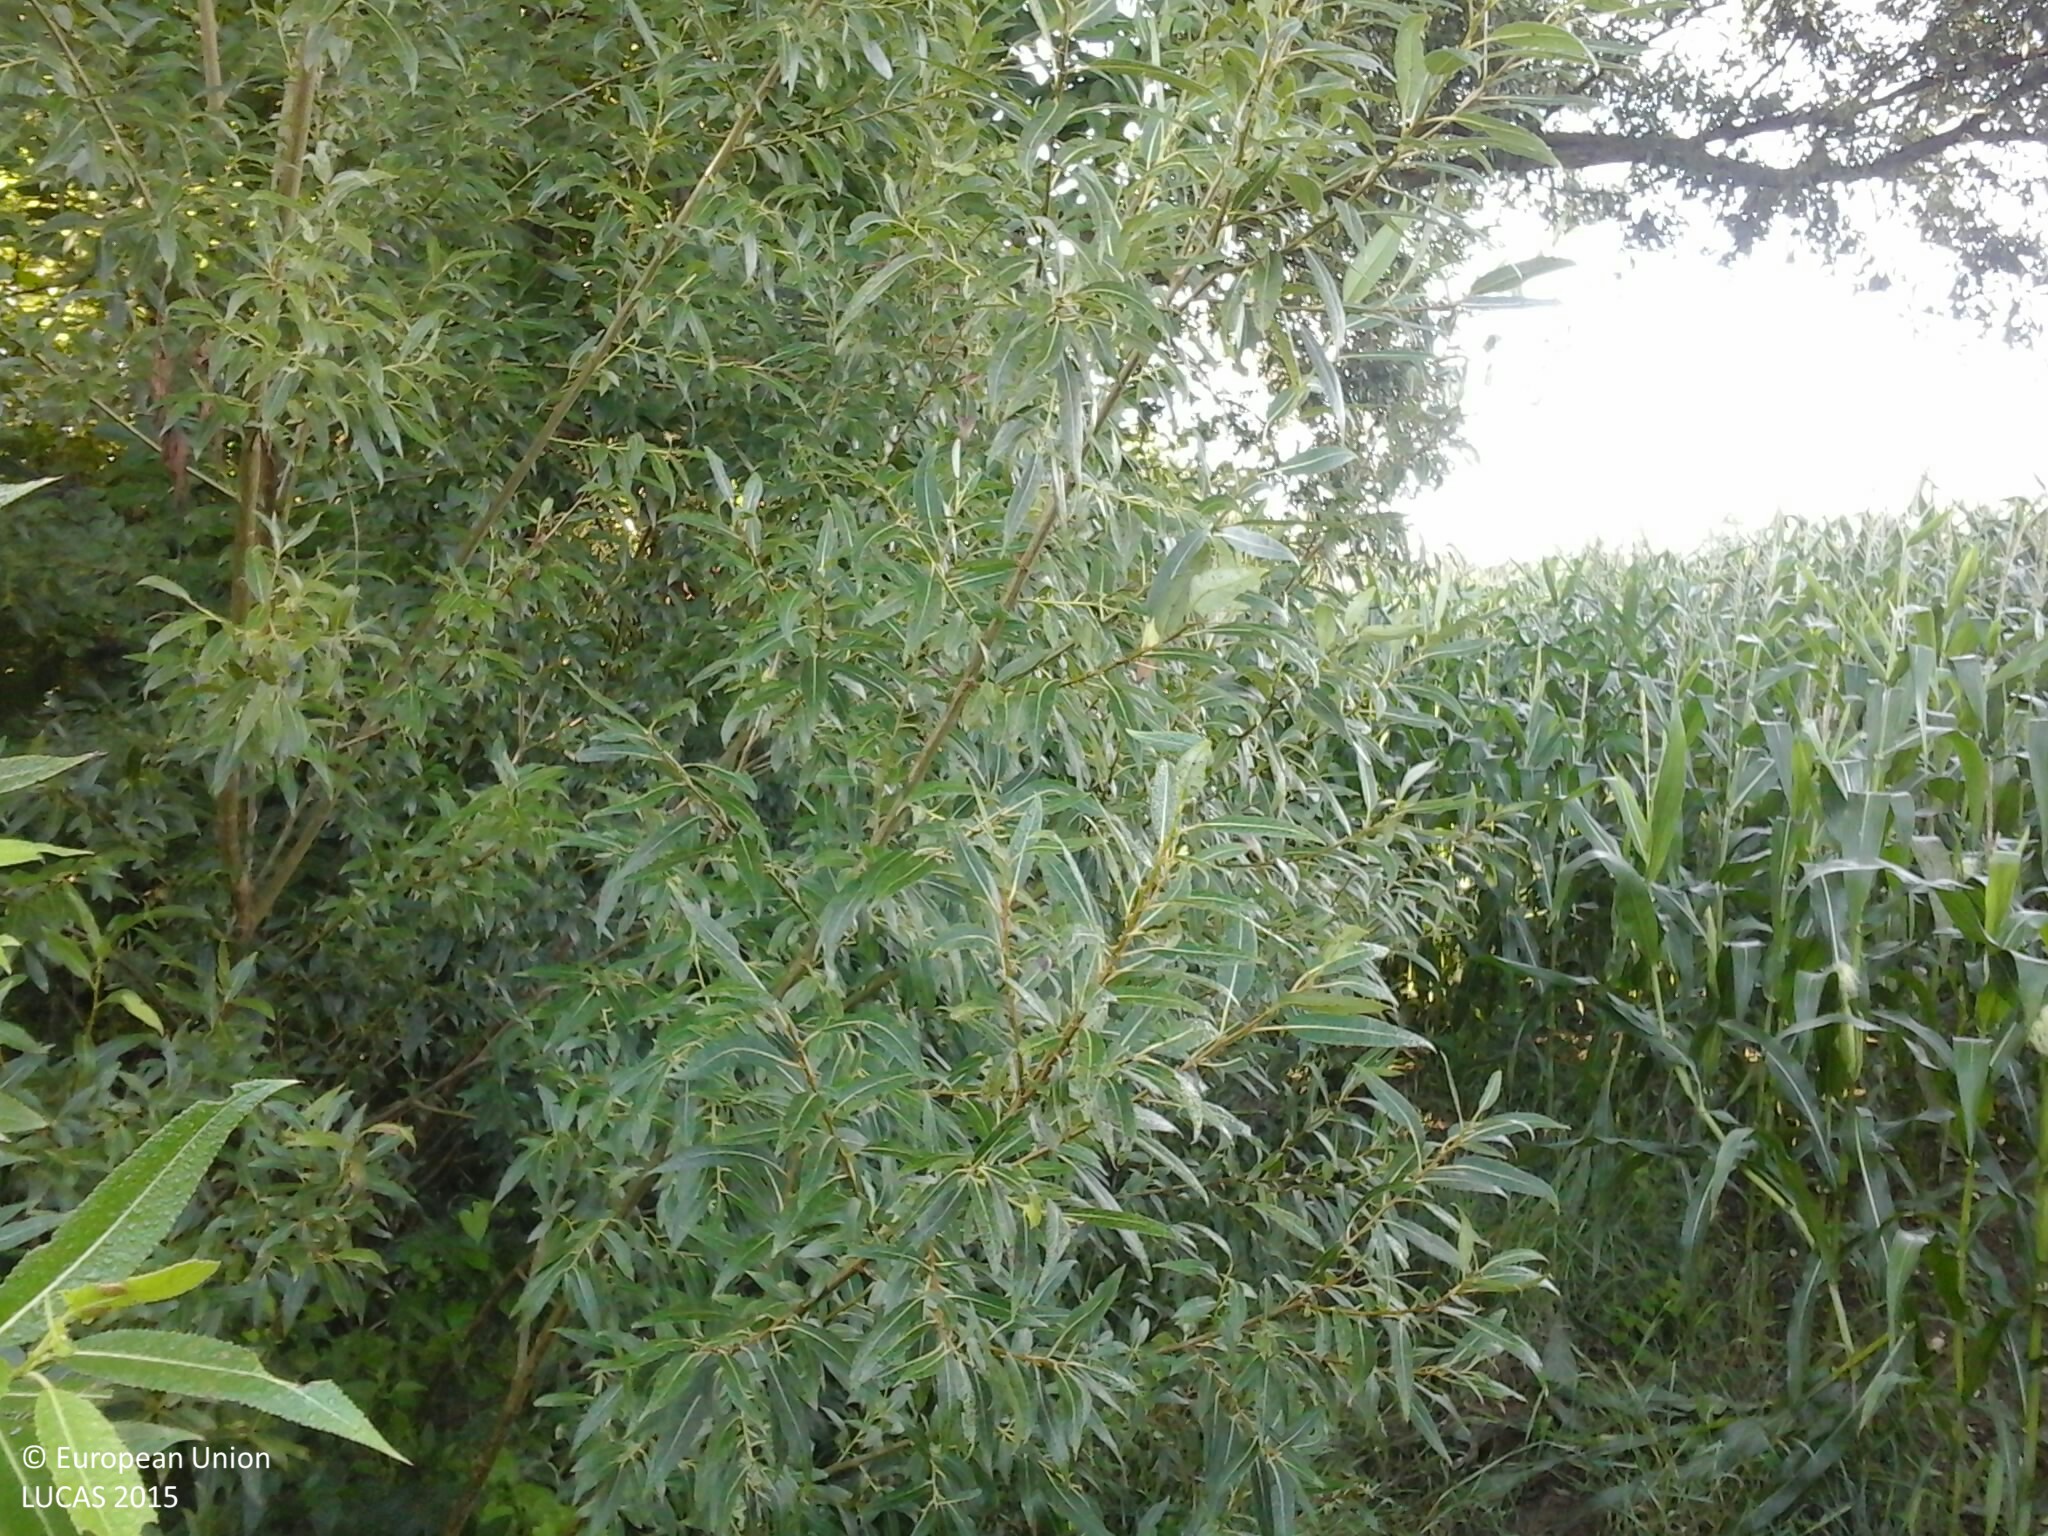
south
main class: Cropland
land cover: Maize
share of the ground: > 75 %
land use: Agriculture (excluding fallow land and kitchen gardens)
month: August
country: HU
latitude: 46.9579
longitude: 16.6390
